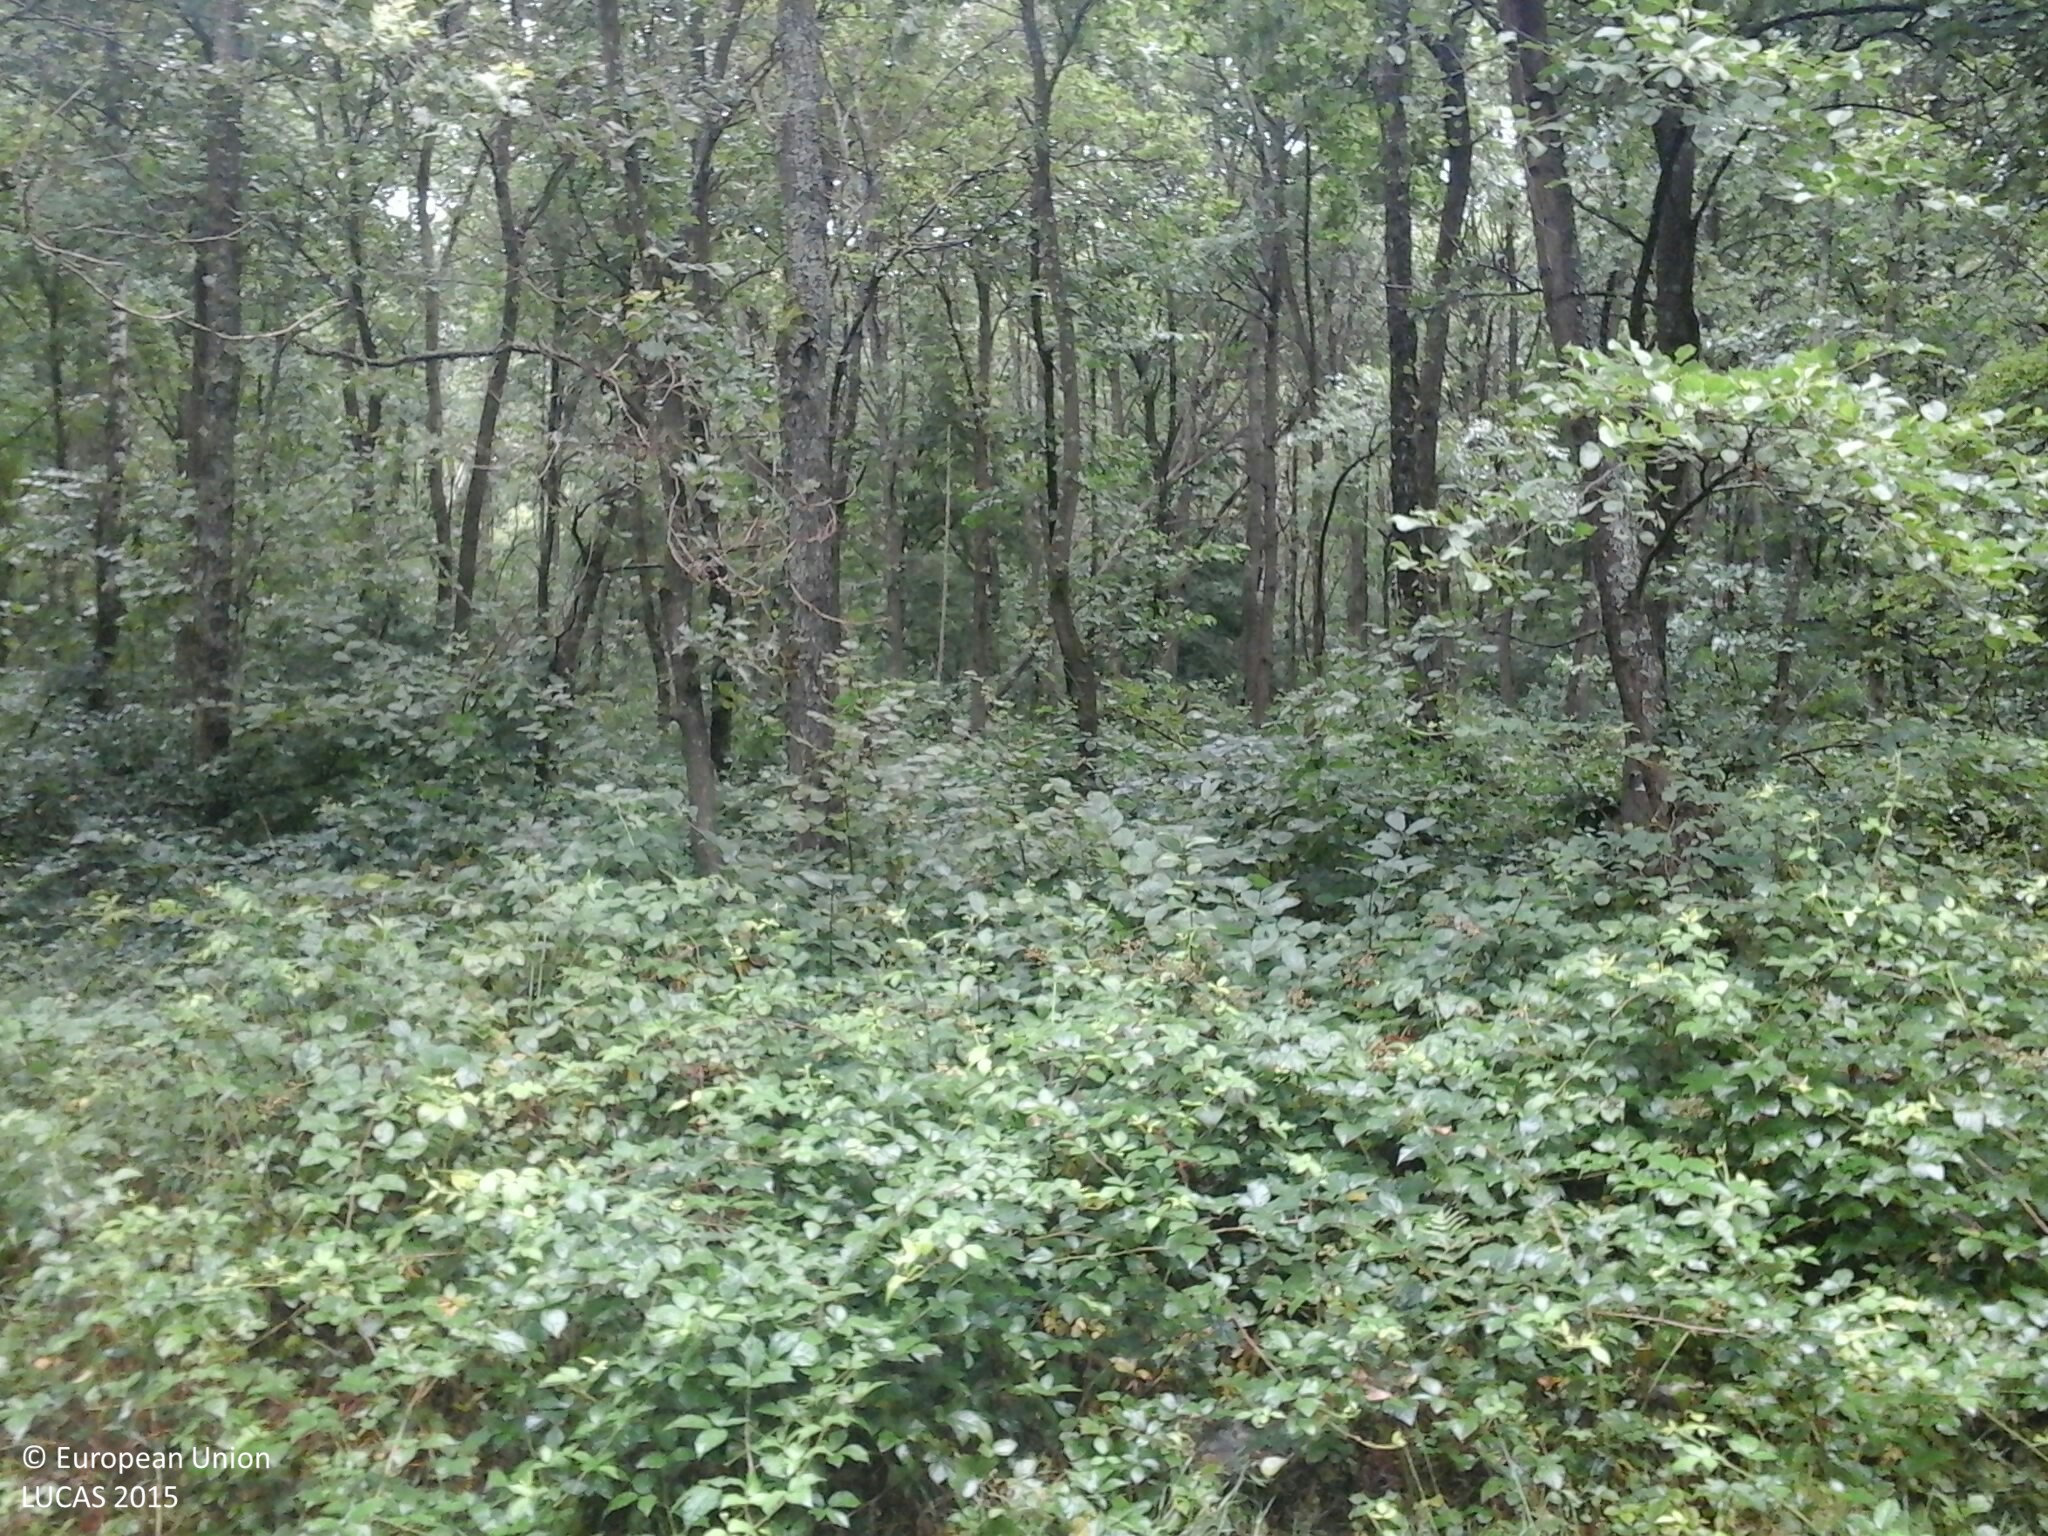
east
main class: Woodland
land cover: Broadleaved woodland
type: mesophytic deciduous forest
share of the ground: > 75 %
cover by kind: broadleaved forest trees 75 %, herbaceous plants 15 %, shrubs 10 %
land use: Forestry
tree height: > 5 m
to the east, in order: Grass margins; Tracks; Broadleaved woodland; Ditches and canals; Broadleaved woodland
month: July
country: HU
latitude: 46.9121
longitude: 16.5015
